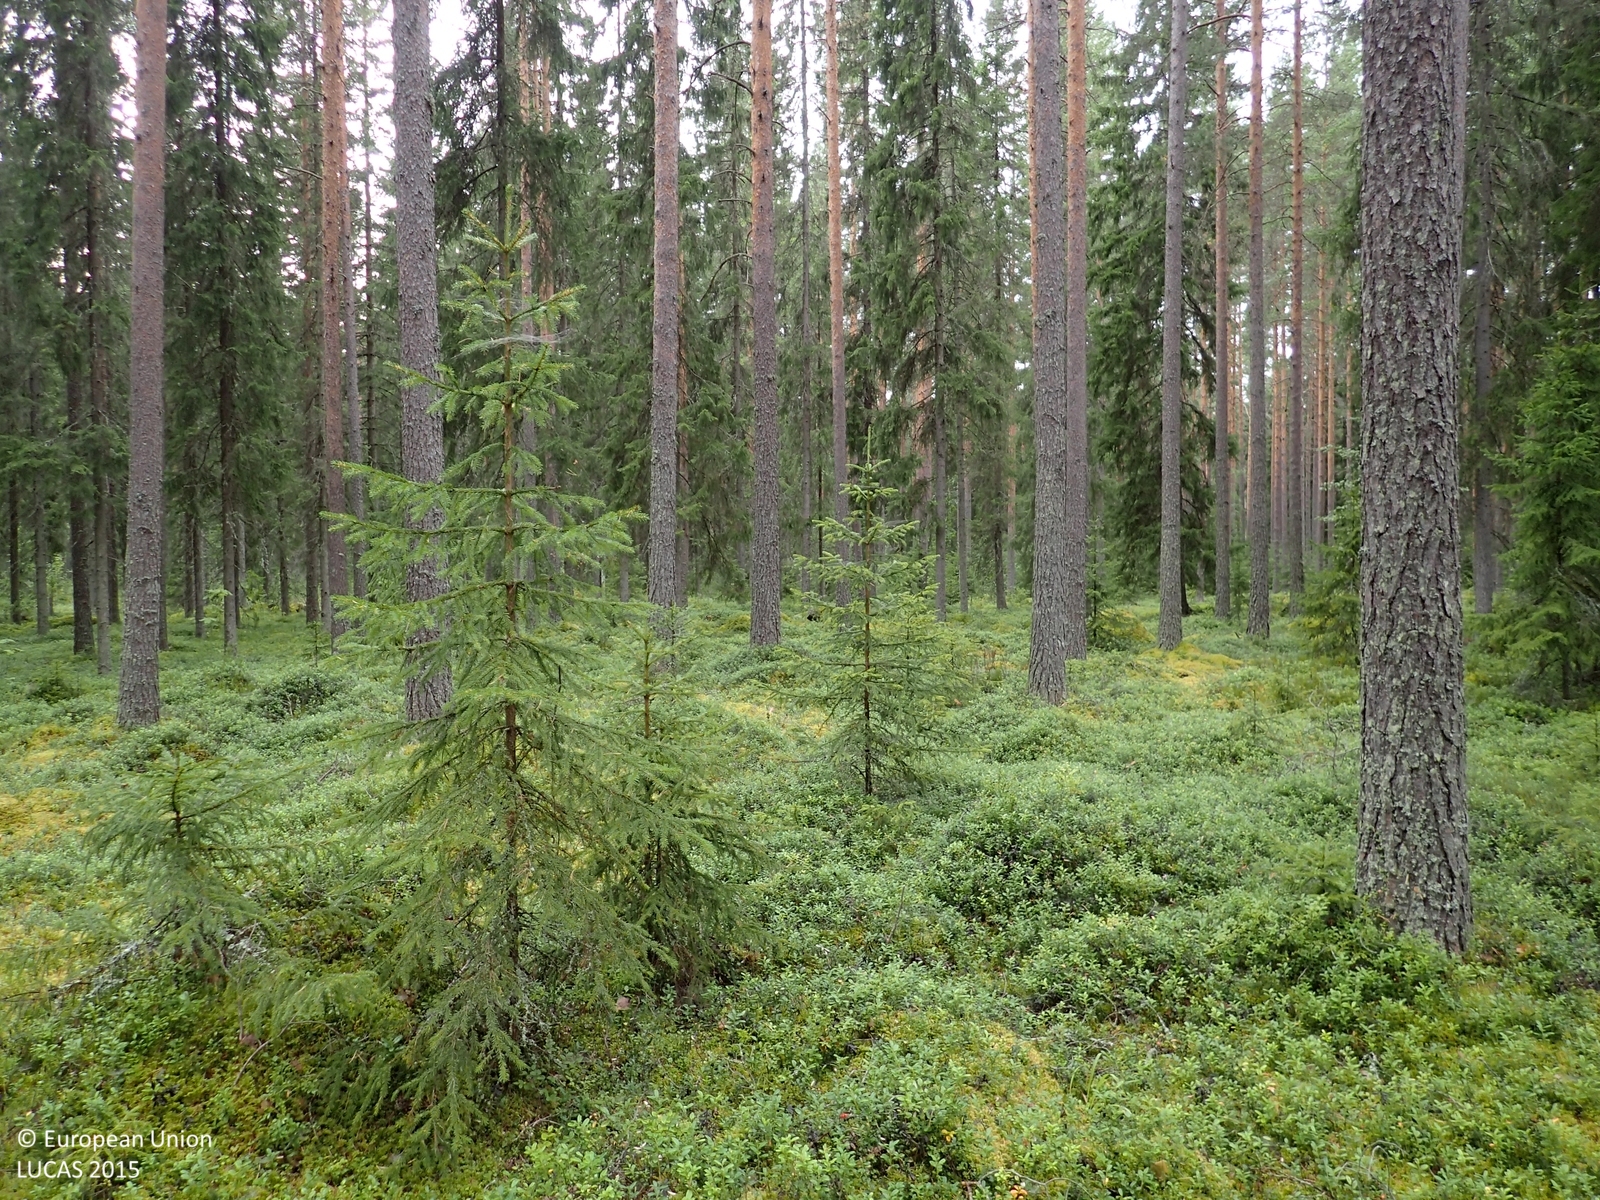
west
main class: Woodland
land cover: Other coniferous woodland
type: boreal forest
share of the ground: 50 - 75 %
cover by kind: coniferous forest trees 70 %, shrubs 20 %, lichens and mosses 10 %
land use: Forestry
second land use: Amenities, museums, leisure
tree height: > 5 m
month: August
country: FI
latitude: 62.7476
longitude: 22.7218
